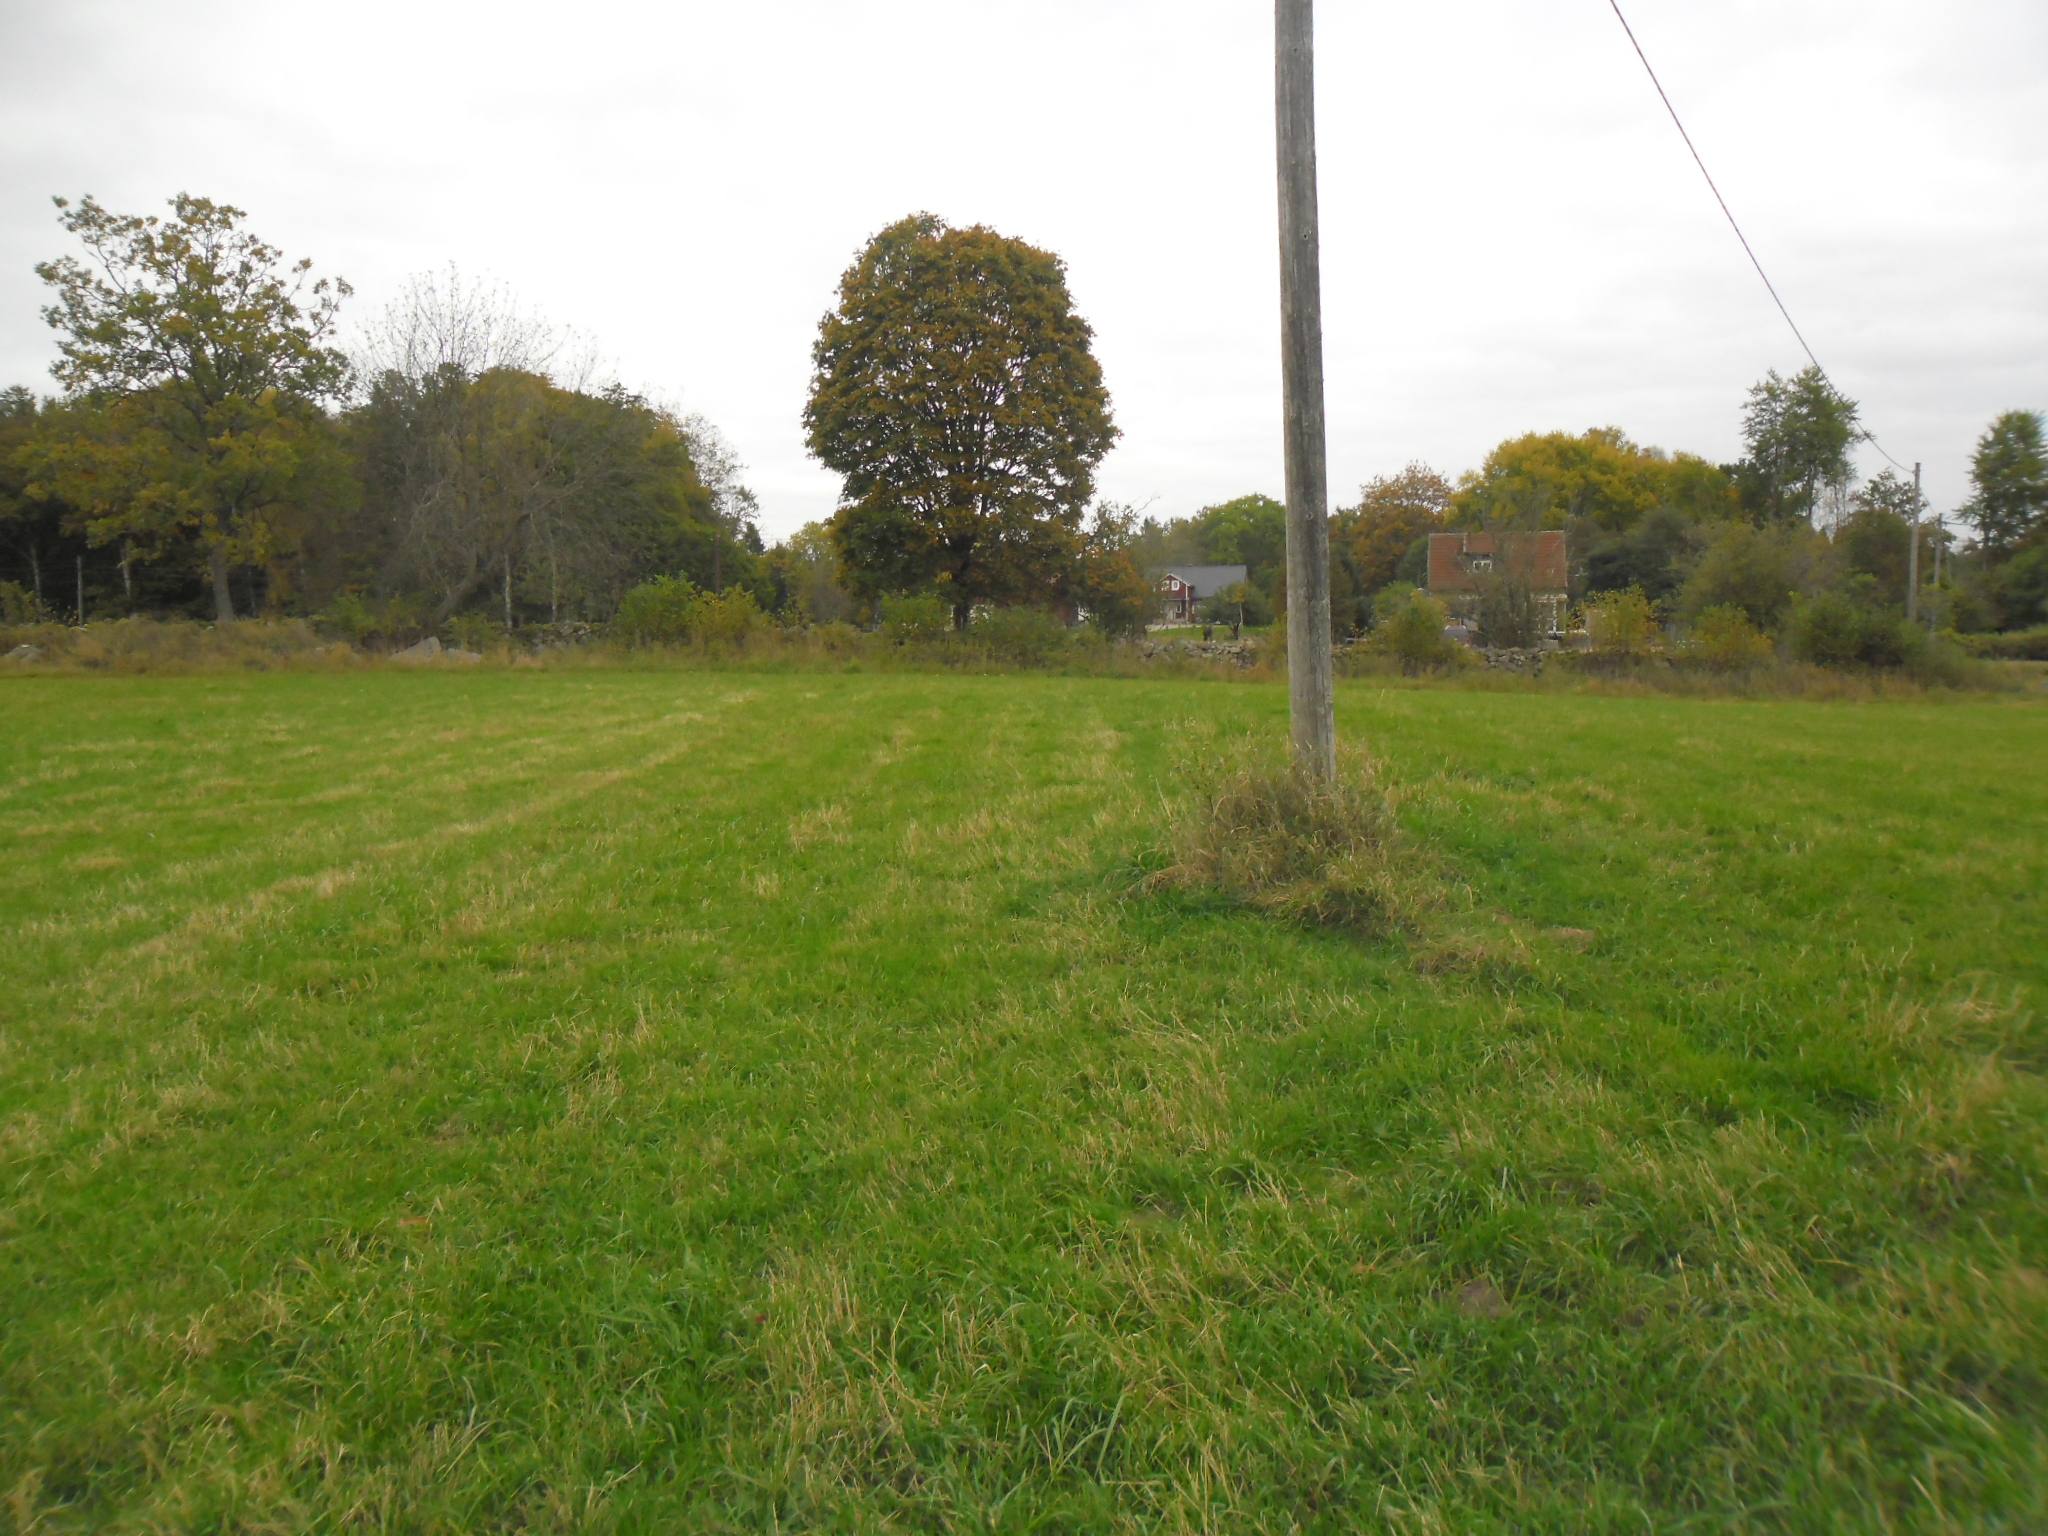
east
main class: Grassland
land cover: Grassland without tree/shrub cover
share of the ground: > 75 %
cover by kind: herbaceous plants 100 %
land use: Agriculture (excluding fallow land and kitchen gardens)
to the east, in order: Grassland without tree/shrub cover; Electric lines; Grassland without tree/shrub cover; Dry stone walls; Grassland without tree/shrub cover; Fences; Grass margins; Paved roads, cycling and walking lanes; Fences; Grassland without tree/shrub cover; Fences; Grassland without tree/shrub cover; Fences; Grassland without tree/shrub cover
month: October
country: SE
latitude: 56.3315
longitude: 13.7334
